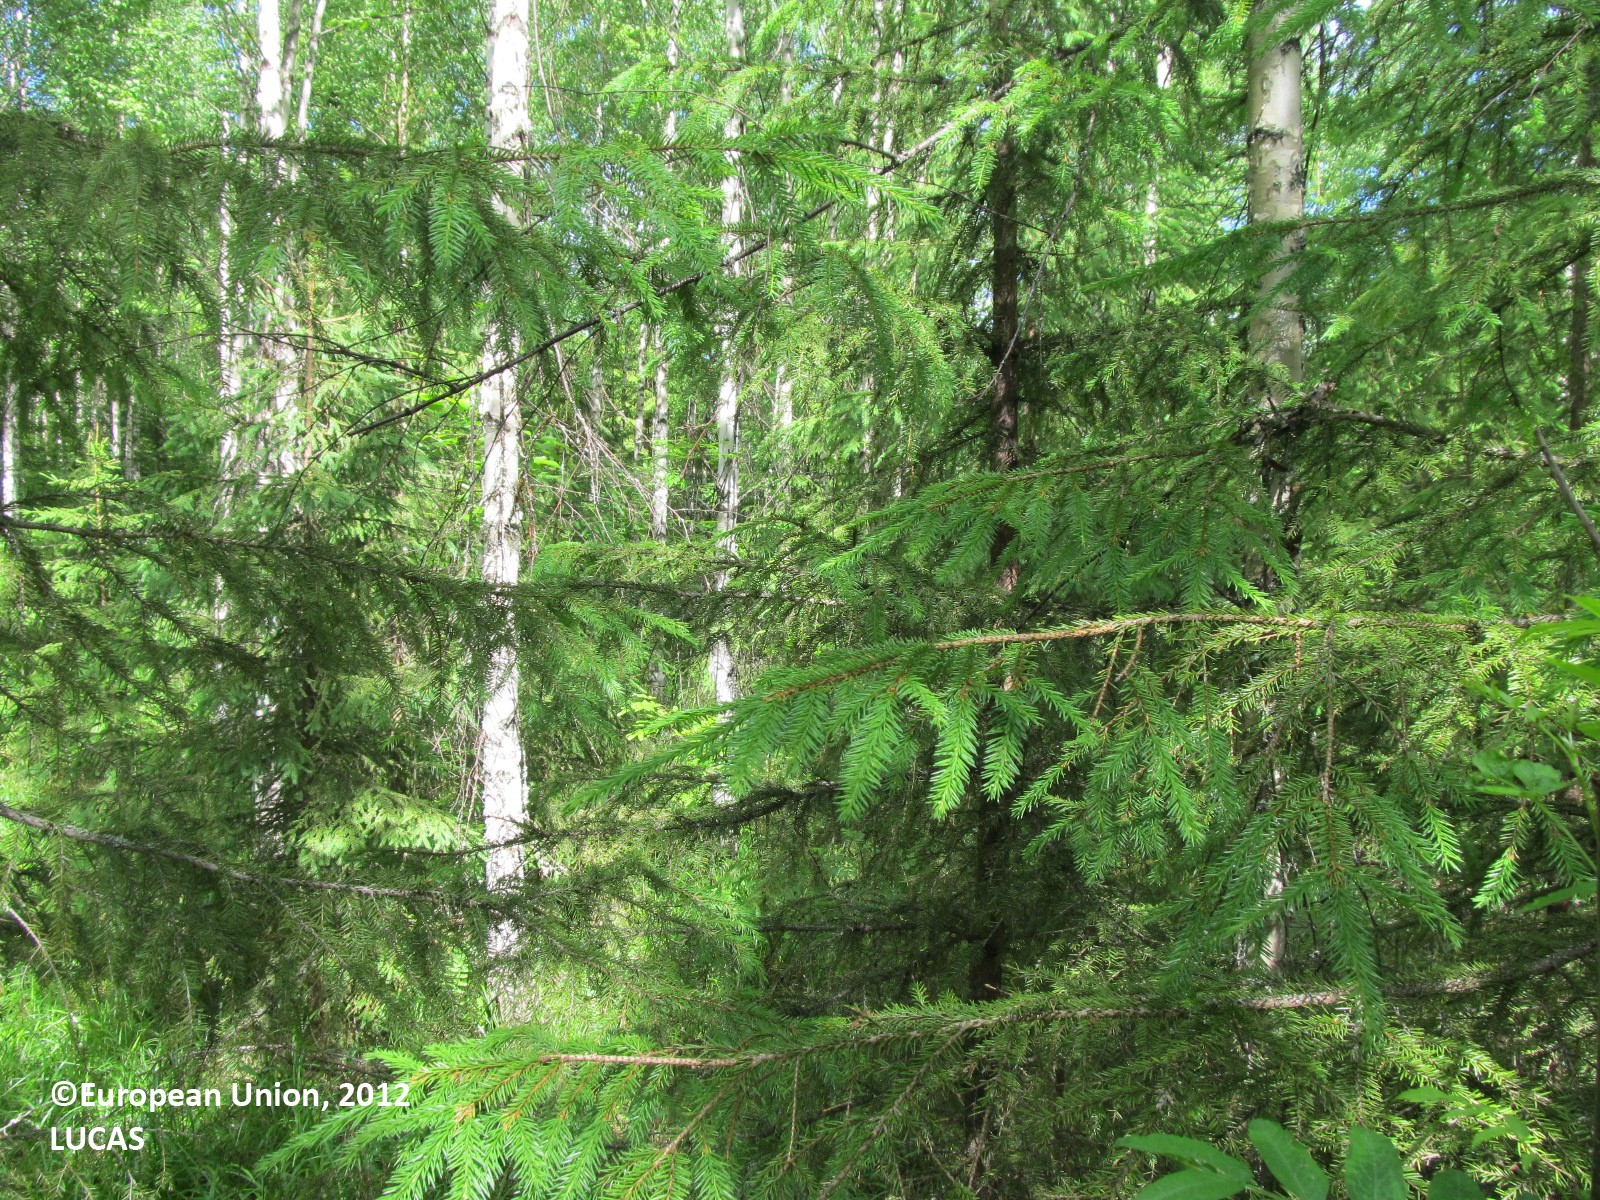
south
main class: Woodland
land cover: Spruce dominated mixed woodland
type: boreal forest
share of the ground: > 75 %
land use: Forestry
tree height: > 5 m
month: June
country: FI
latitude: 62.6658
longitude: 28.8954
